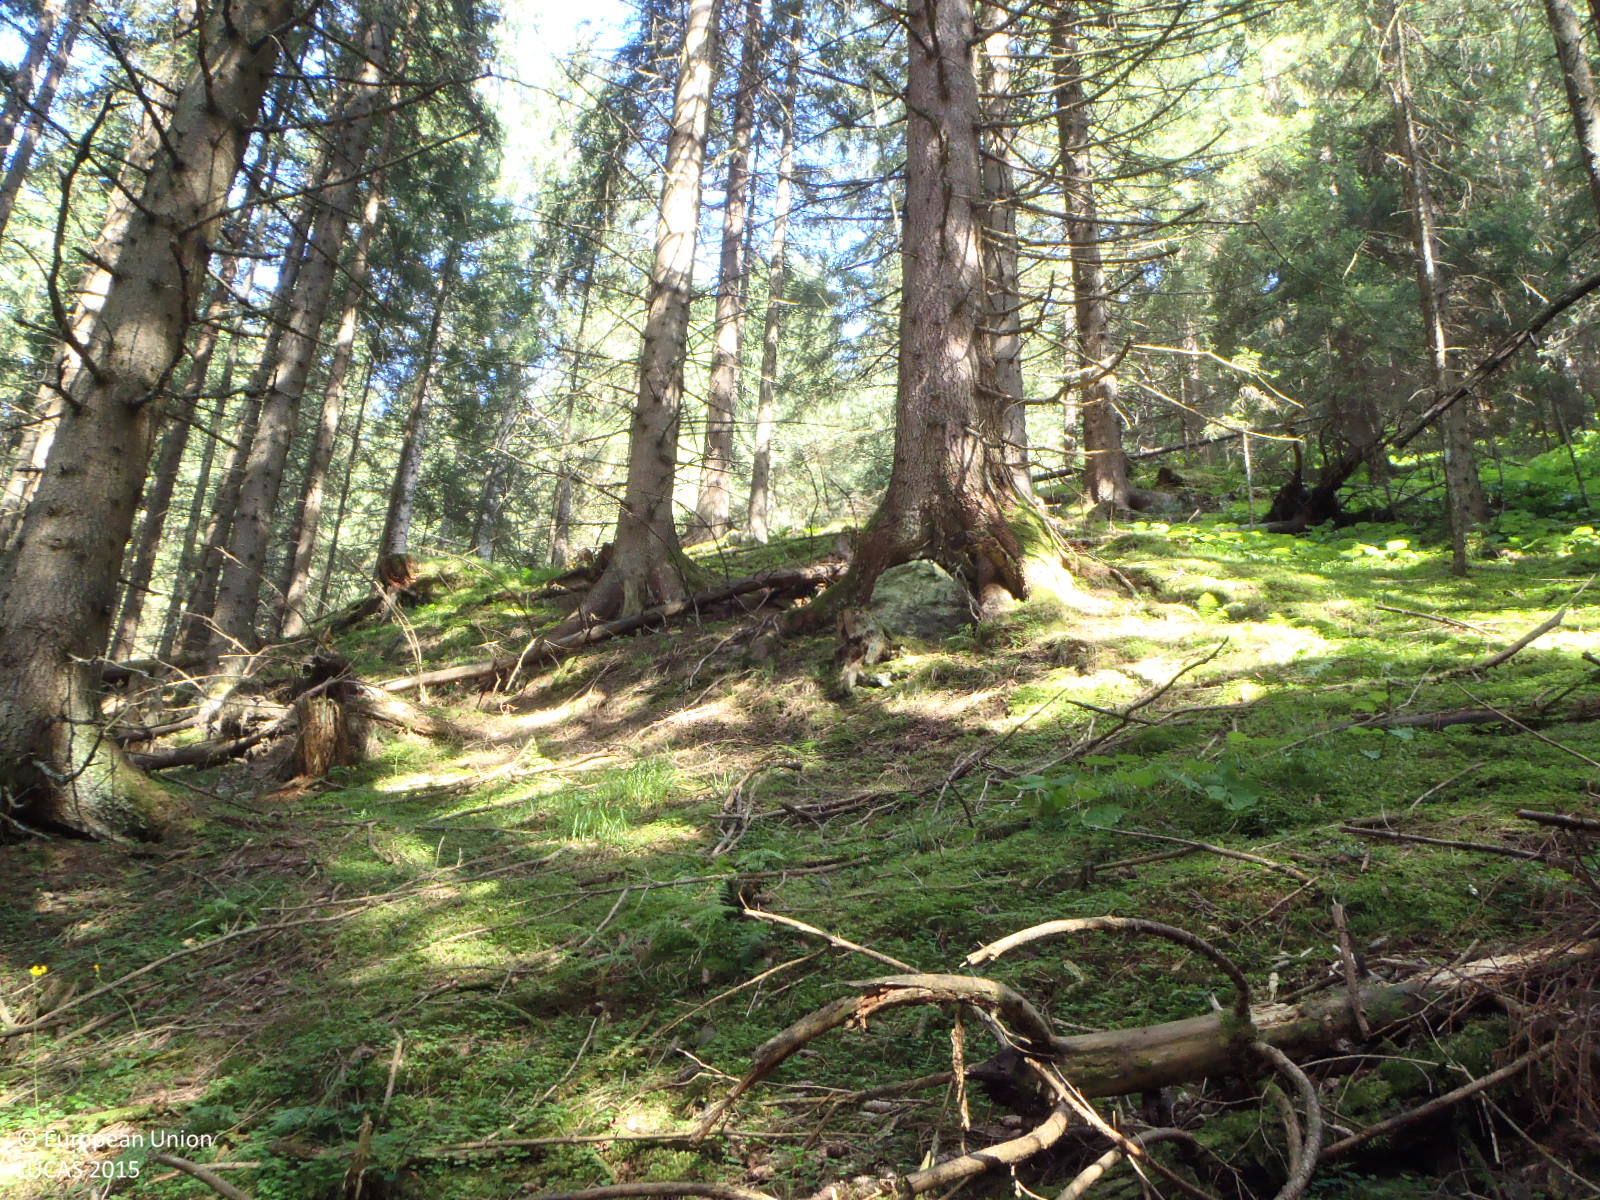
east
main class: Woodland
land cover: Spruce dominated coniferous woodland
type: alpine coniferous forest
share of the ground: > 75 %
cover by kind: coniferous forest trees 80 %, herbaceous plants 10 %, lichens and mosses 10 %
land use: Forestry
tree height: > 5 m
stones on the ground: < 10 %
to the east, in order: Spruce dominated coniferous woodland; Grassland with sparse tree/shrub cover; Spruce dominated coniferous woodland; Fences; Spruce dominated coniferous woodland; Rivers and streams; Spruce dominated coniferous woodland
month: July
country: AT
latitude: 47.3787
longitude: 11.9190
